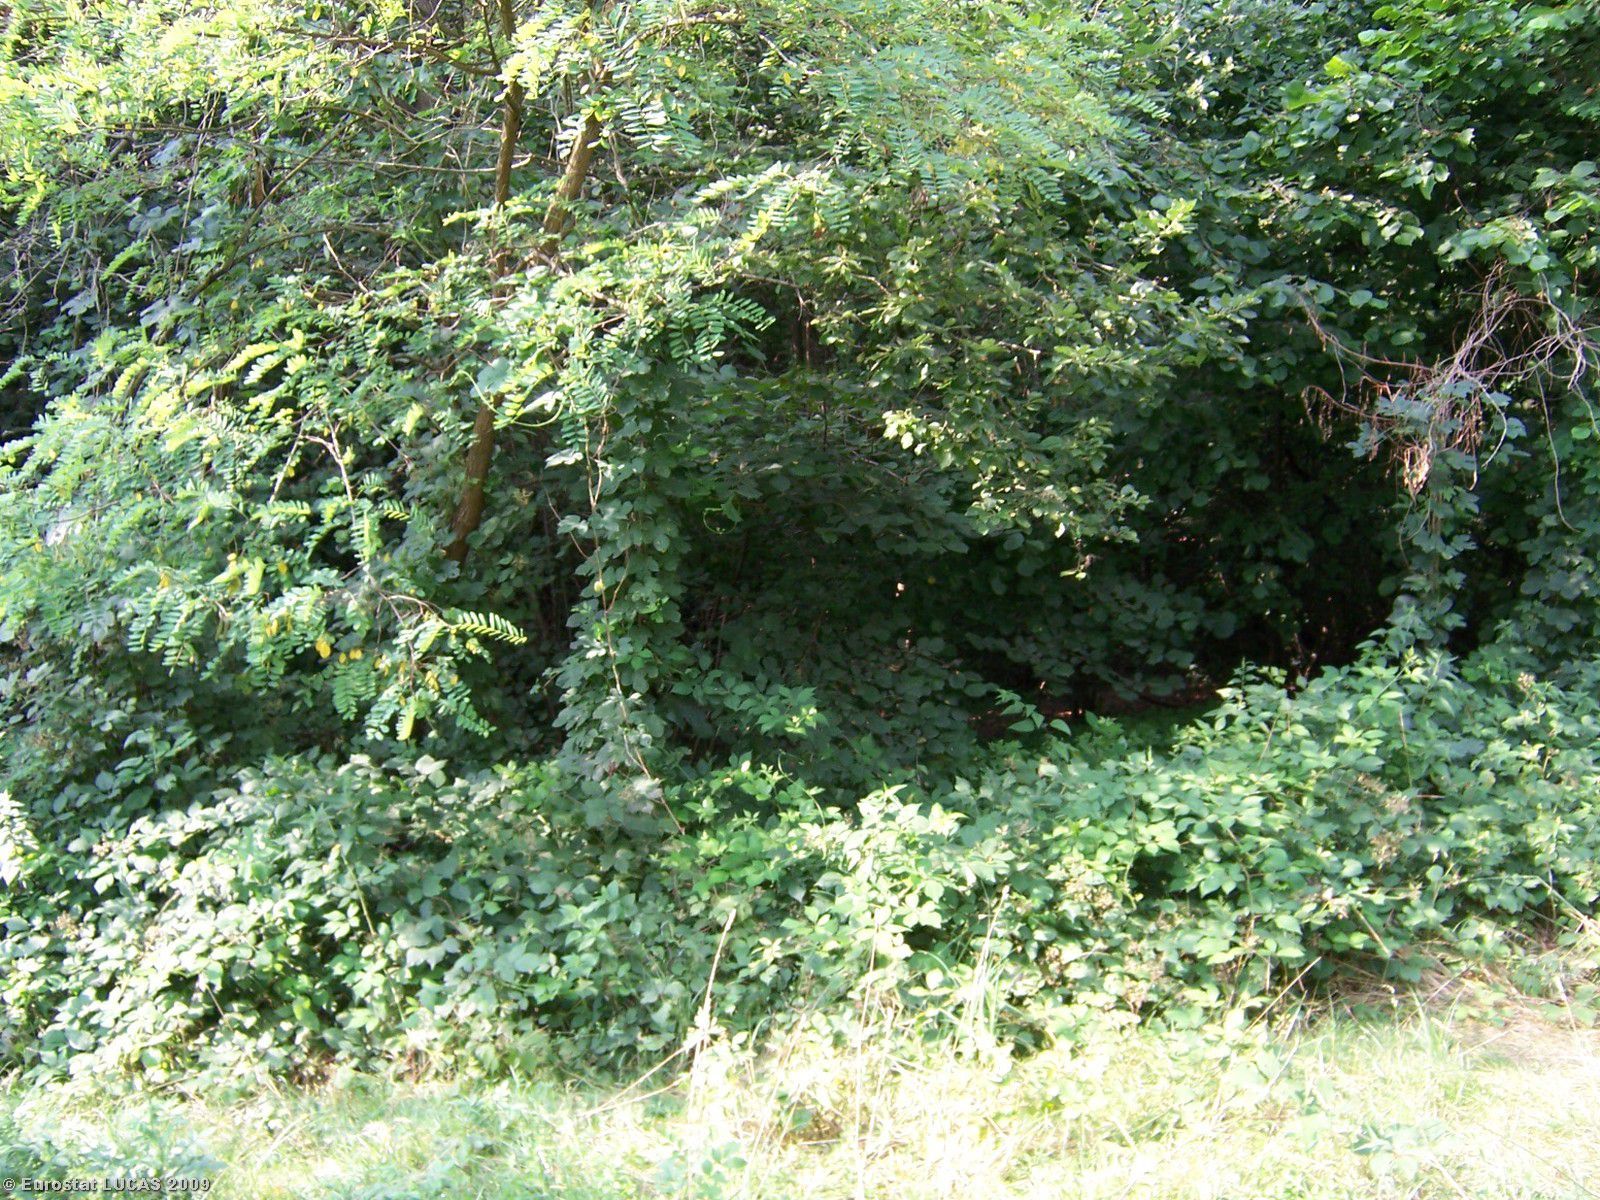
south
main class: Cropland
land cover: Apple fruit
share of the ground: > 75 %
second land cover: Grassland with sparse tree/shrub cover
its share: > 75 %
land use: Agriculture (excluding fallow land and kitchen gardens)
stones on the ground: < 10 %
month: July
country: IT
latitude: 44.9670
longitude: 7.3801
